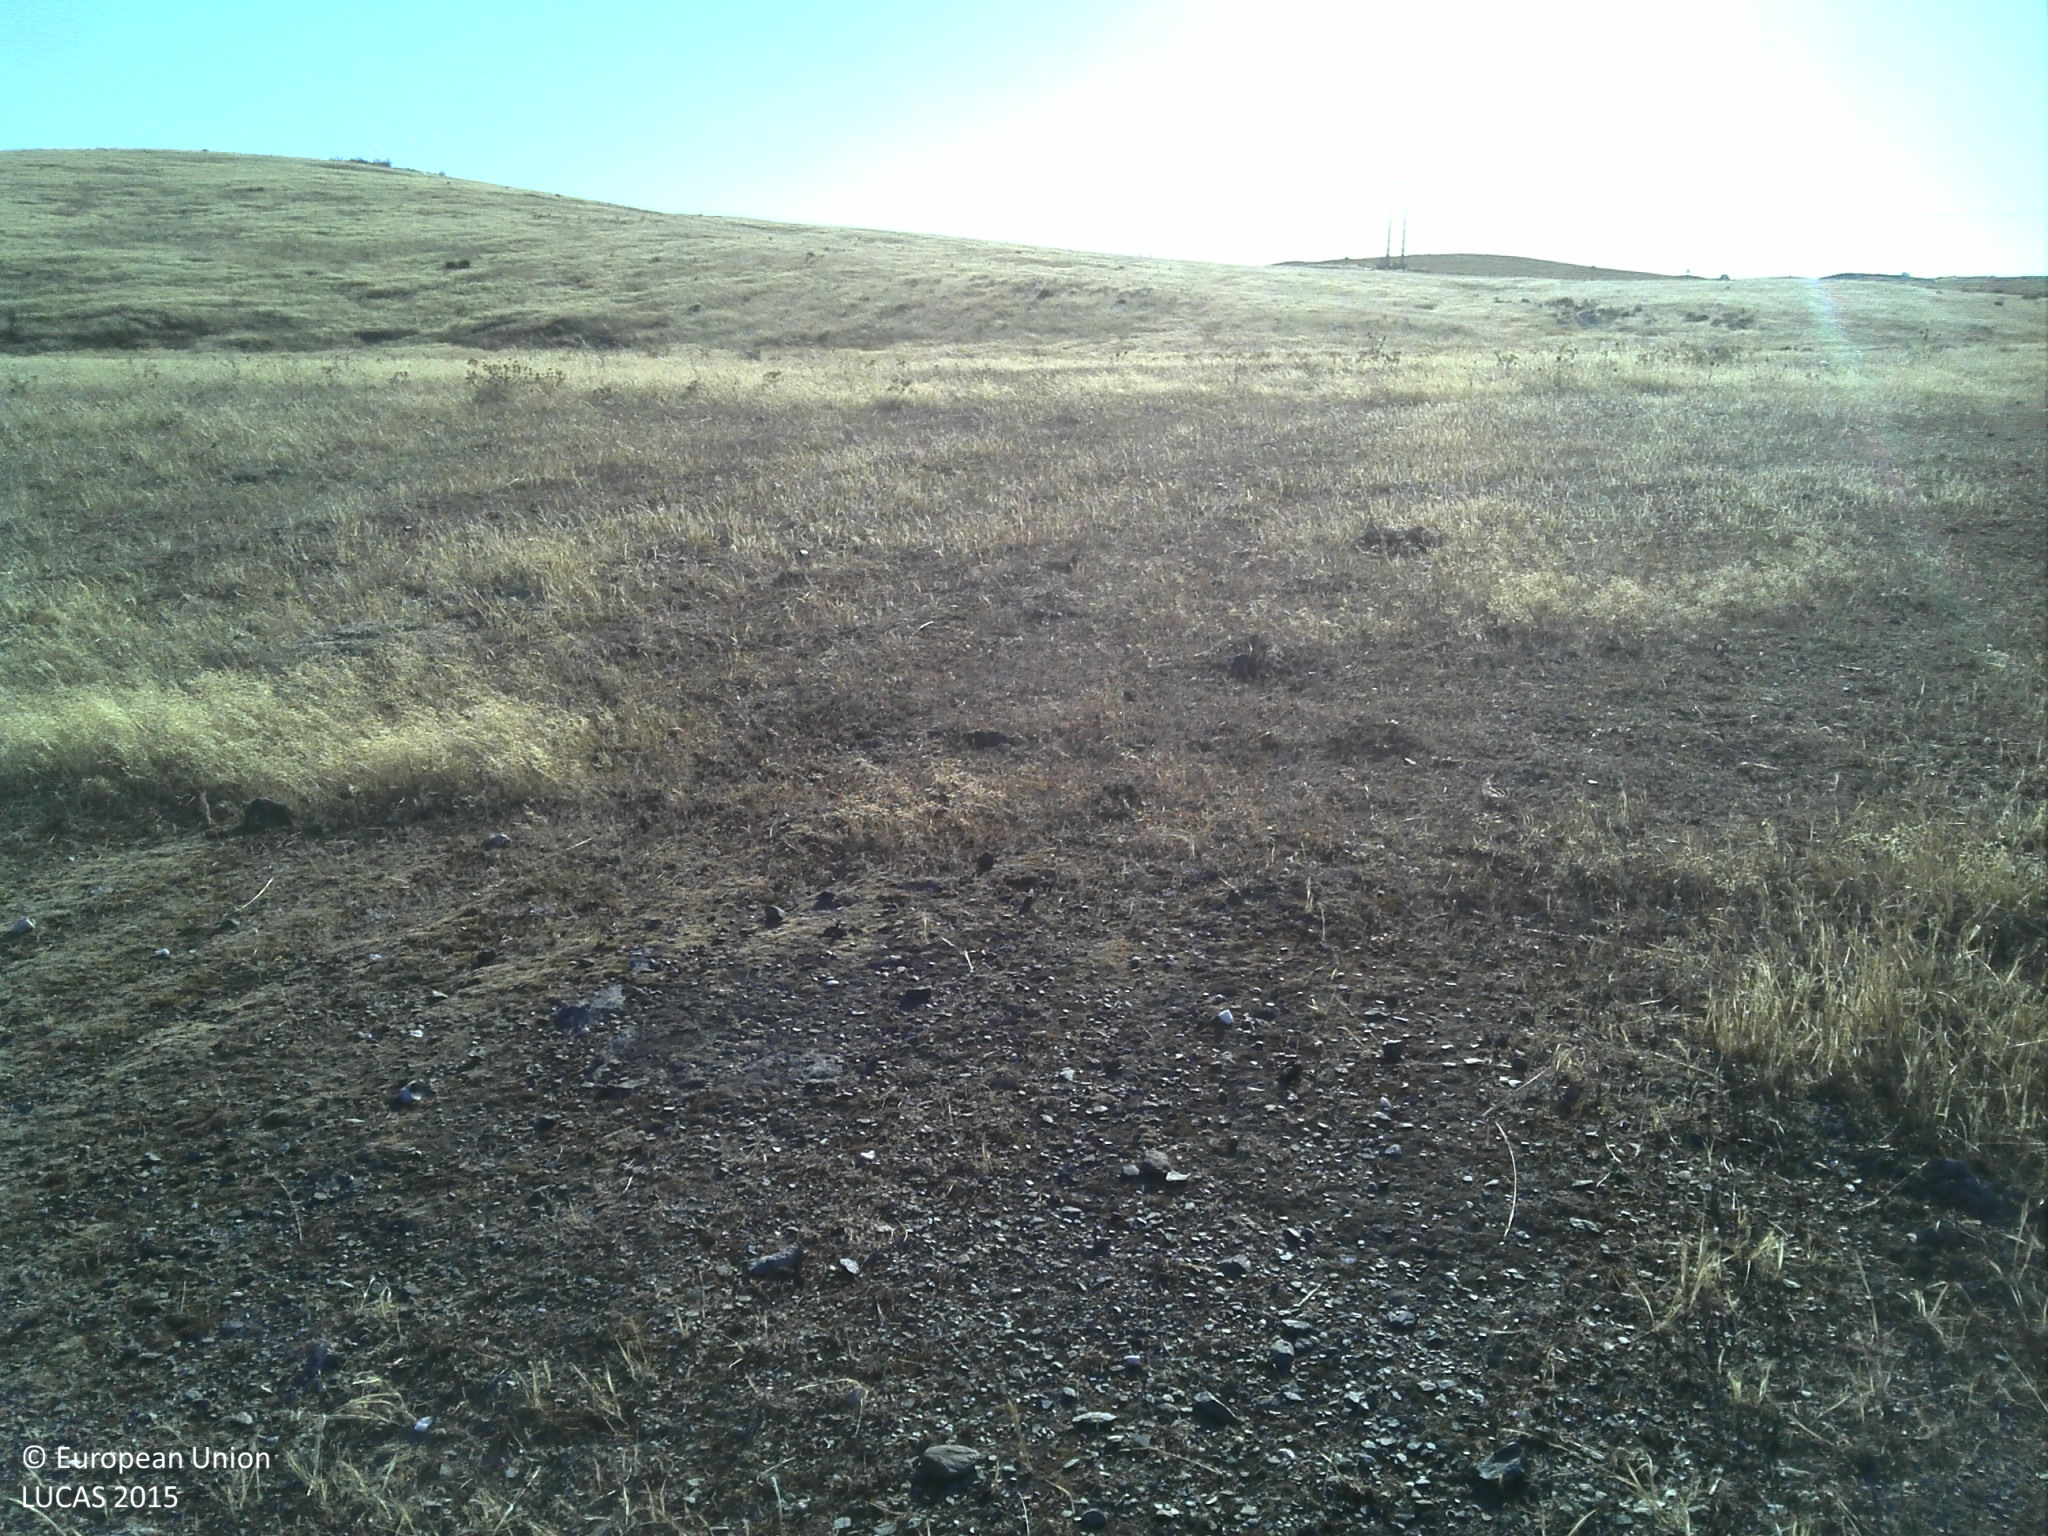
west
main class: Grassland
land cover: Grassland without tree/shrub cover
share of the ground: < 10 %
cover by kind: unconsolidated bare surface 90 %, herbaceous plants 10 %
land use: Agriculture (excluding fallow land and kitchen gardens)
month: July
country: PT
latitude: 37.6632
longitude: -7.8987
